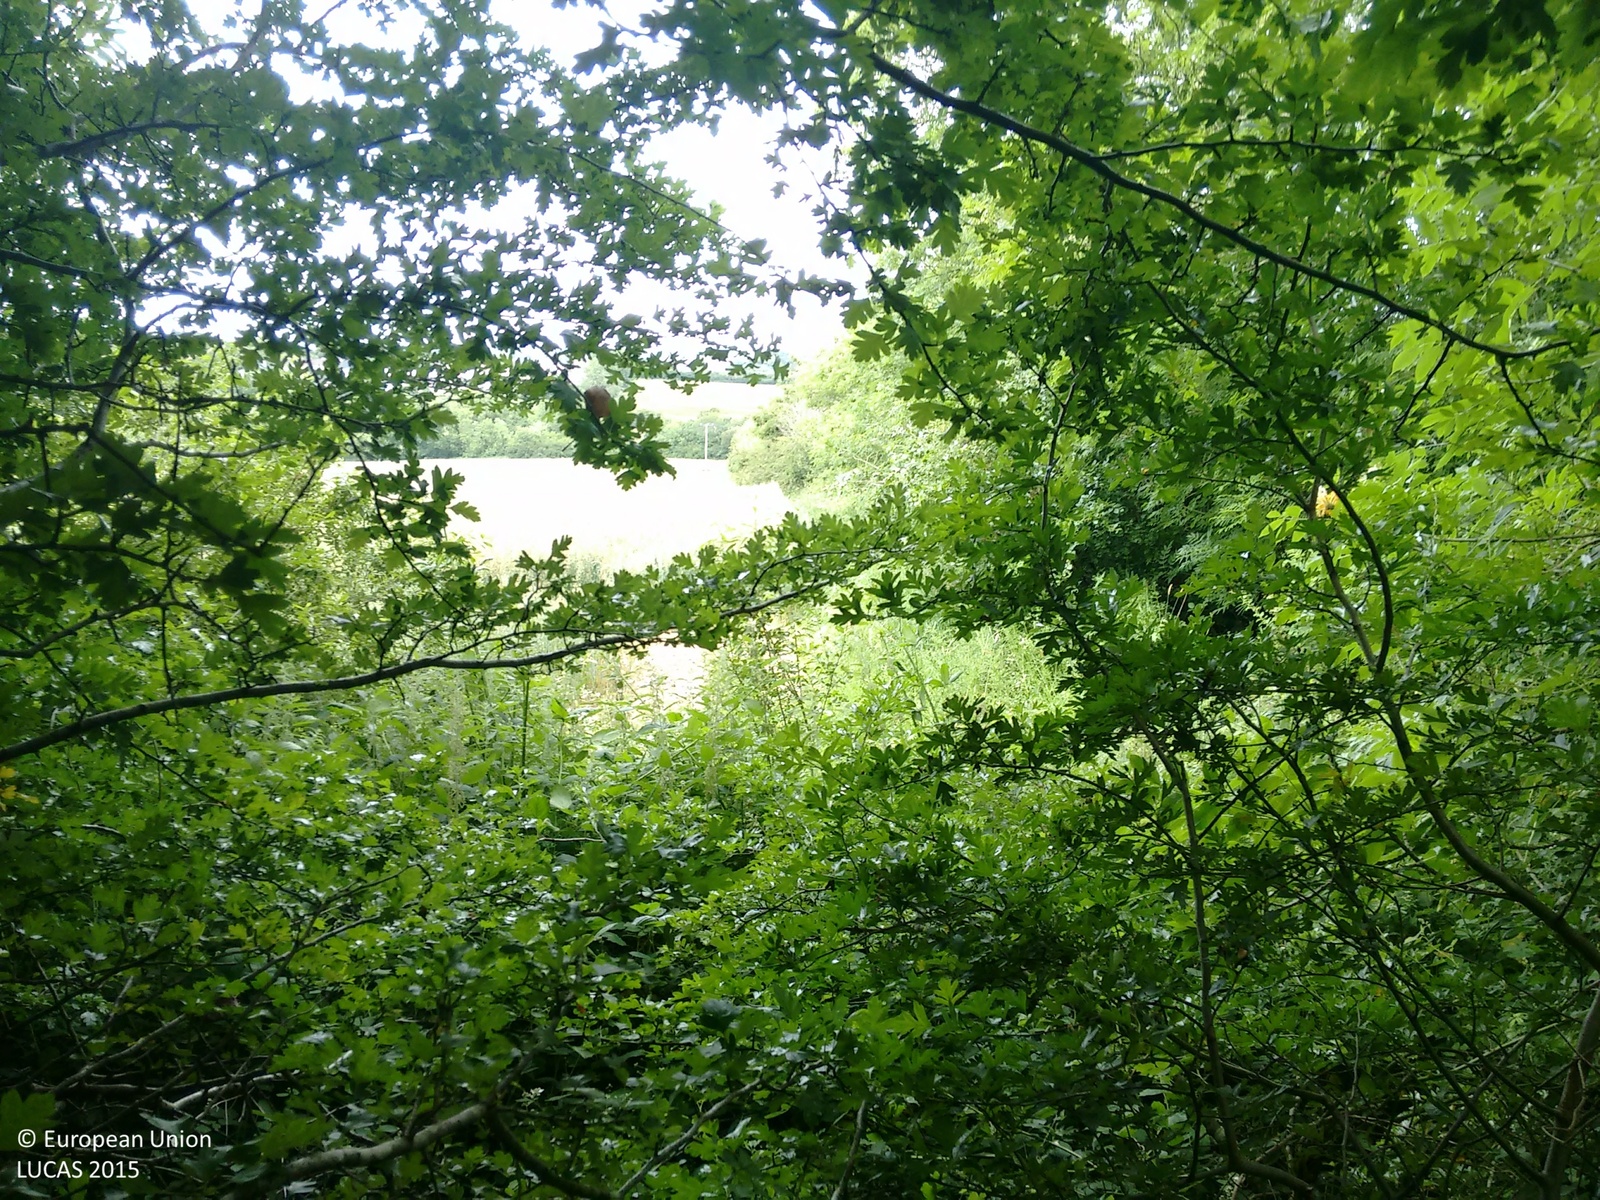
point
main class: Cropland
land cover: Oats
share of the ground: > 75 %
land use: Agriculture (excluding fallow land and kitchen gardens)
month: July
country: IE
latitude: 52.1685
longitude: -8.9097
